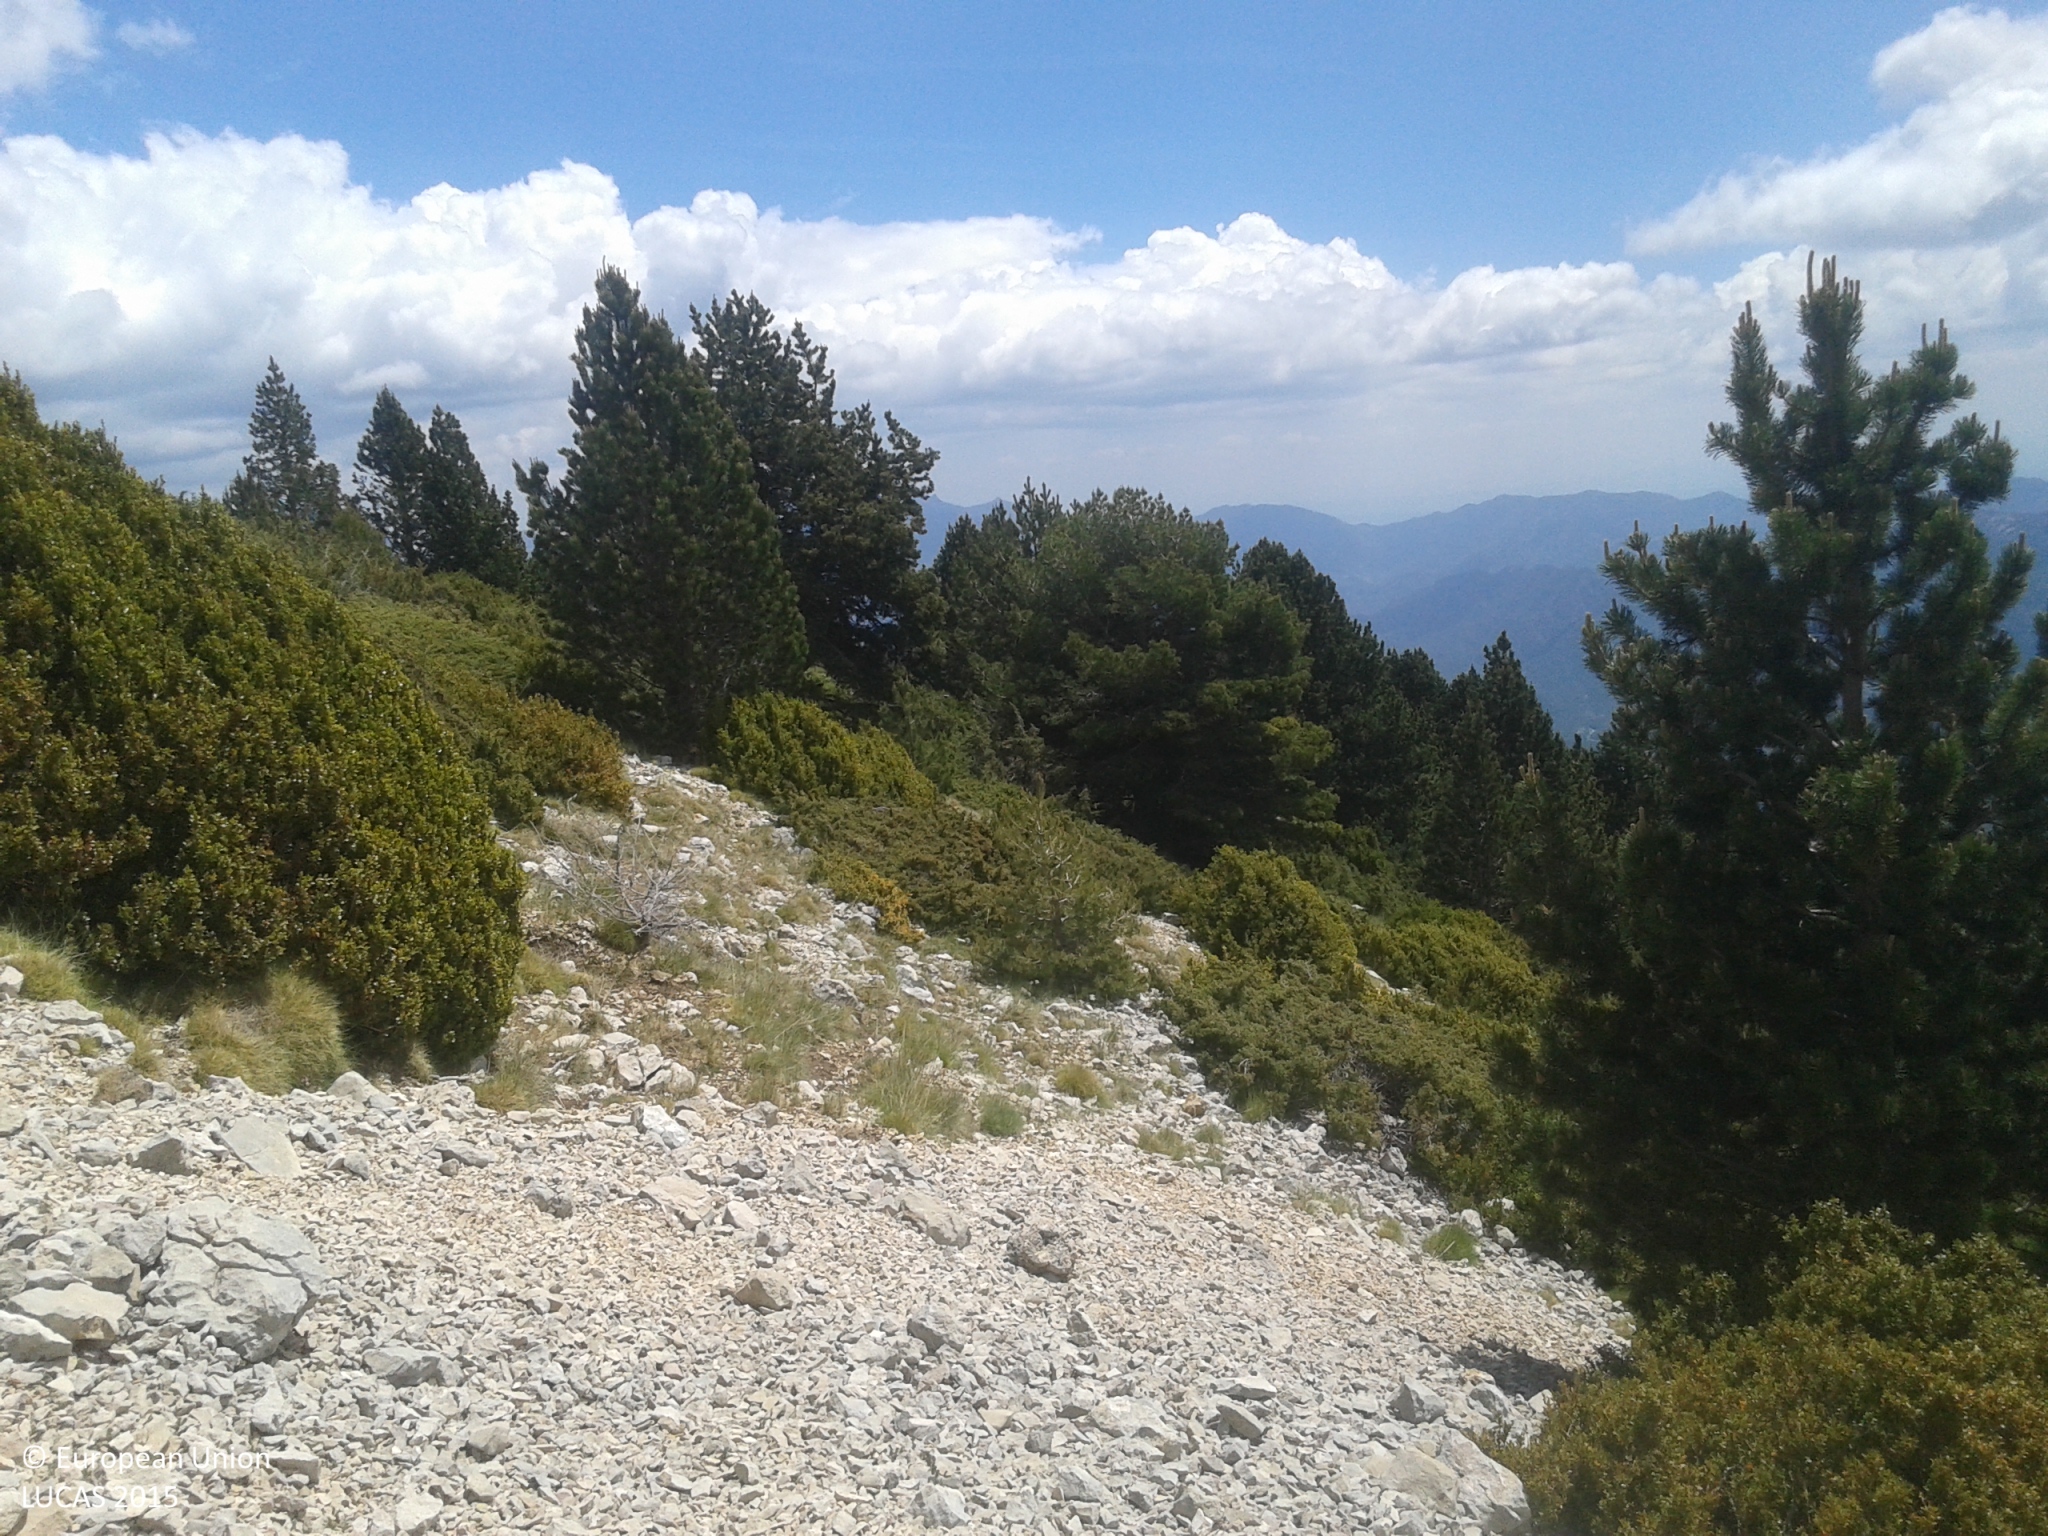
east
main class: Woodland
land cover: Pine dominated coniferous woodland
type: alpine coniferous forest
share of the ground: 10 - 25 %
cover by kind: unconsolidated bare surface 80 %, coniferous forest trees 15 %, shrubs 5 %
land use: Semi-natural and natural areas not in use
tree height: > 5 m
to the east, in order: Pine dominated coniferous woodland; Rocks and stones; Pine dominated coniferous woodland
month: May
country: ES
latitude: 42.1554
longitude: 1.5521
